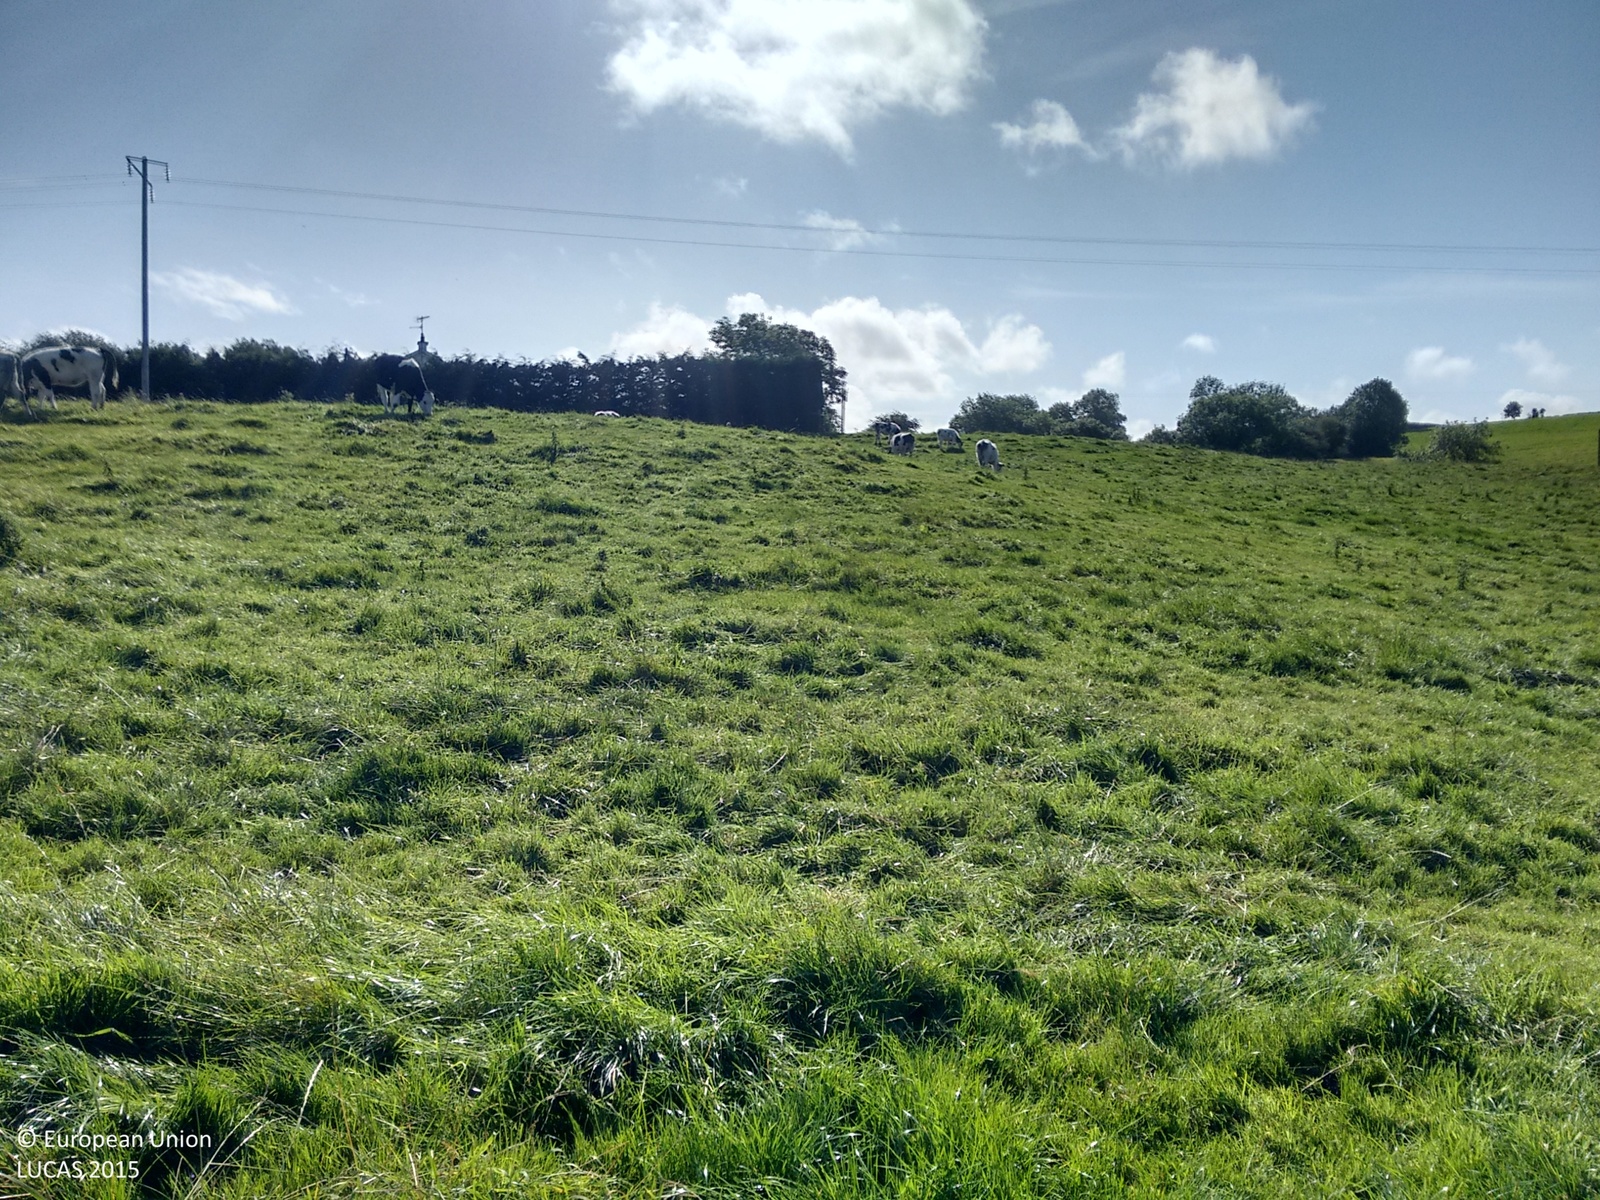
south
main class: Grassland
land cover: Grassland without tree/shrub cover
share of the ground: > 75 %
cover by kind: herbaceous plants 95 %, consolidated bare surface 5 %
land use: Agriculture (excluding fallow land and kitchen gardens)
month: September
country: IE
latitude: 54.1207
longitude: -6.8591
